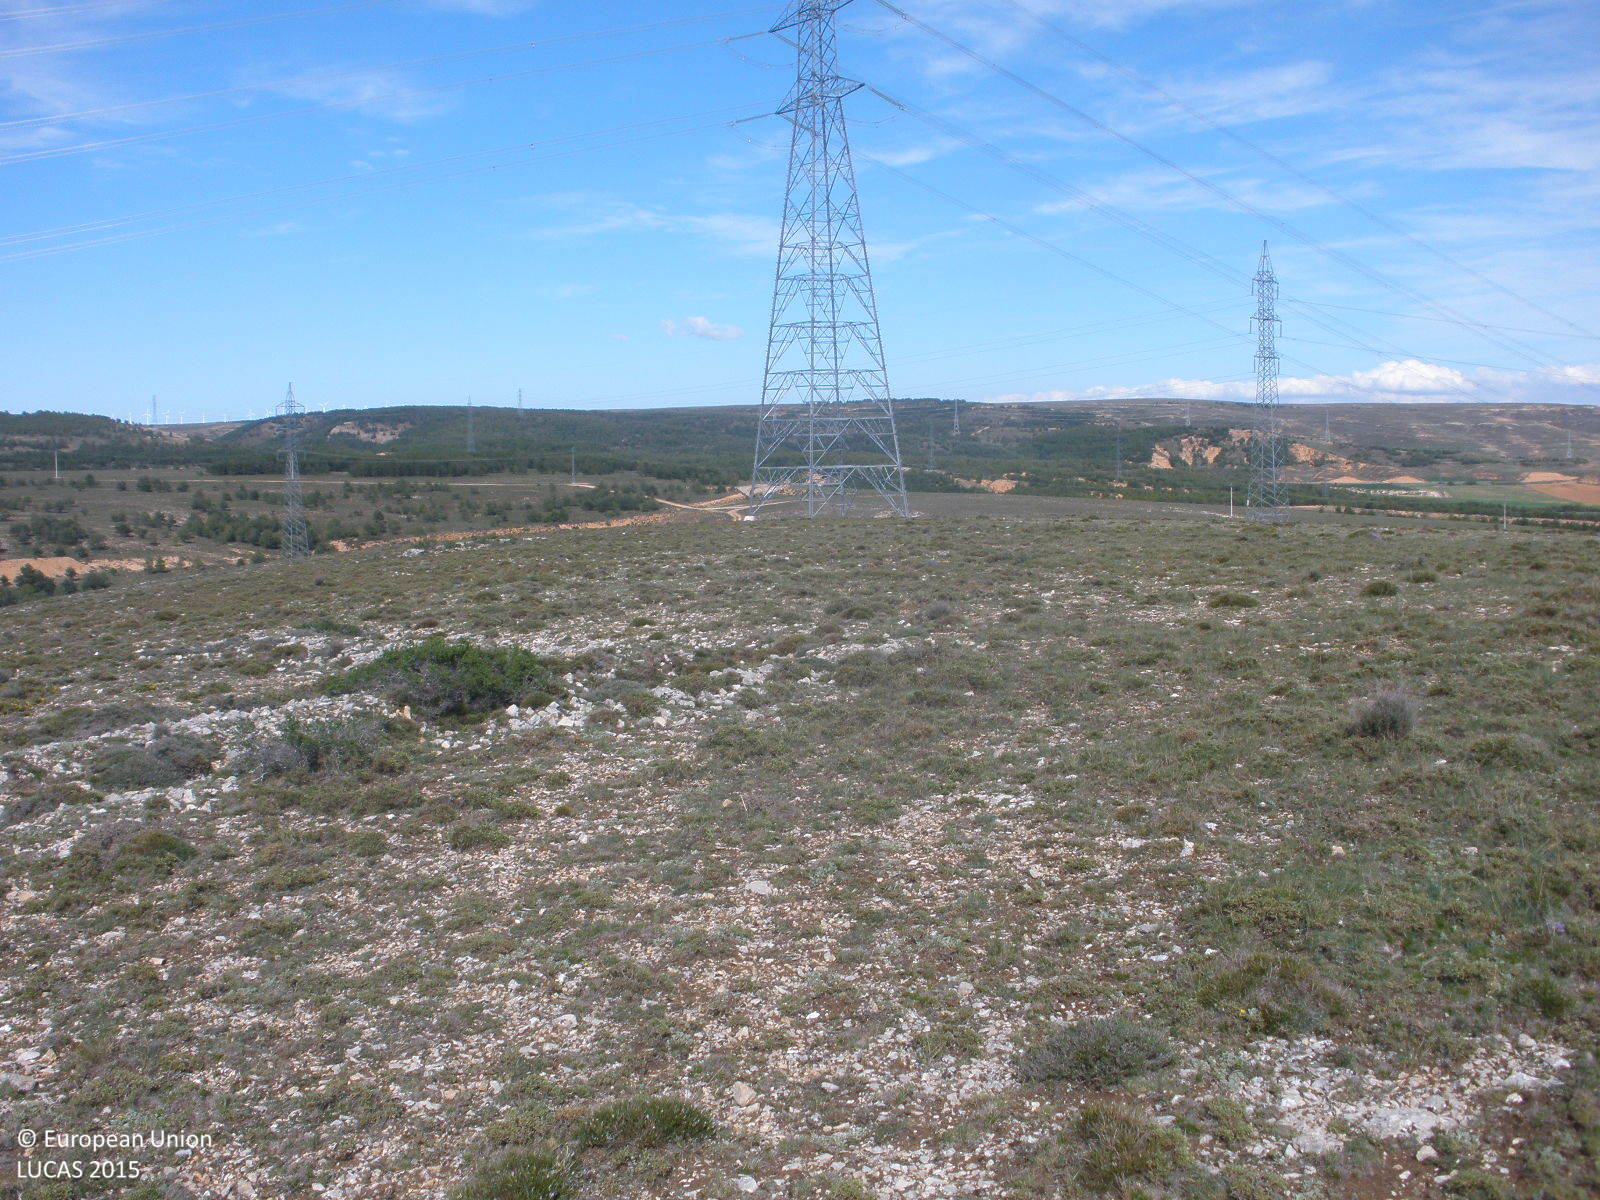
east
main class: Shrubland
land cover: Shrubland without tree cover
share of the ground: 50 - 75 %
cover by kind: shrubs 50 %, consolidated bare surface 30 %, herbaceous plants 20 %
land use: Semi-natural and natural areas not in use
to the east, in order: Shrubland without tree cover; Electric lines; Shrubland without tree cover; Electric lines; Shrubland without tree cover
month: May
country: ES
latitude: 40.7372
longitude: -0.8717
